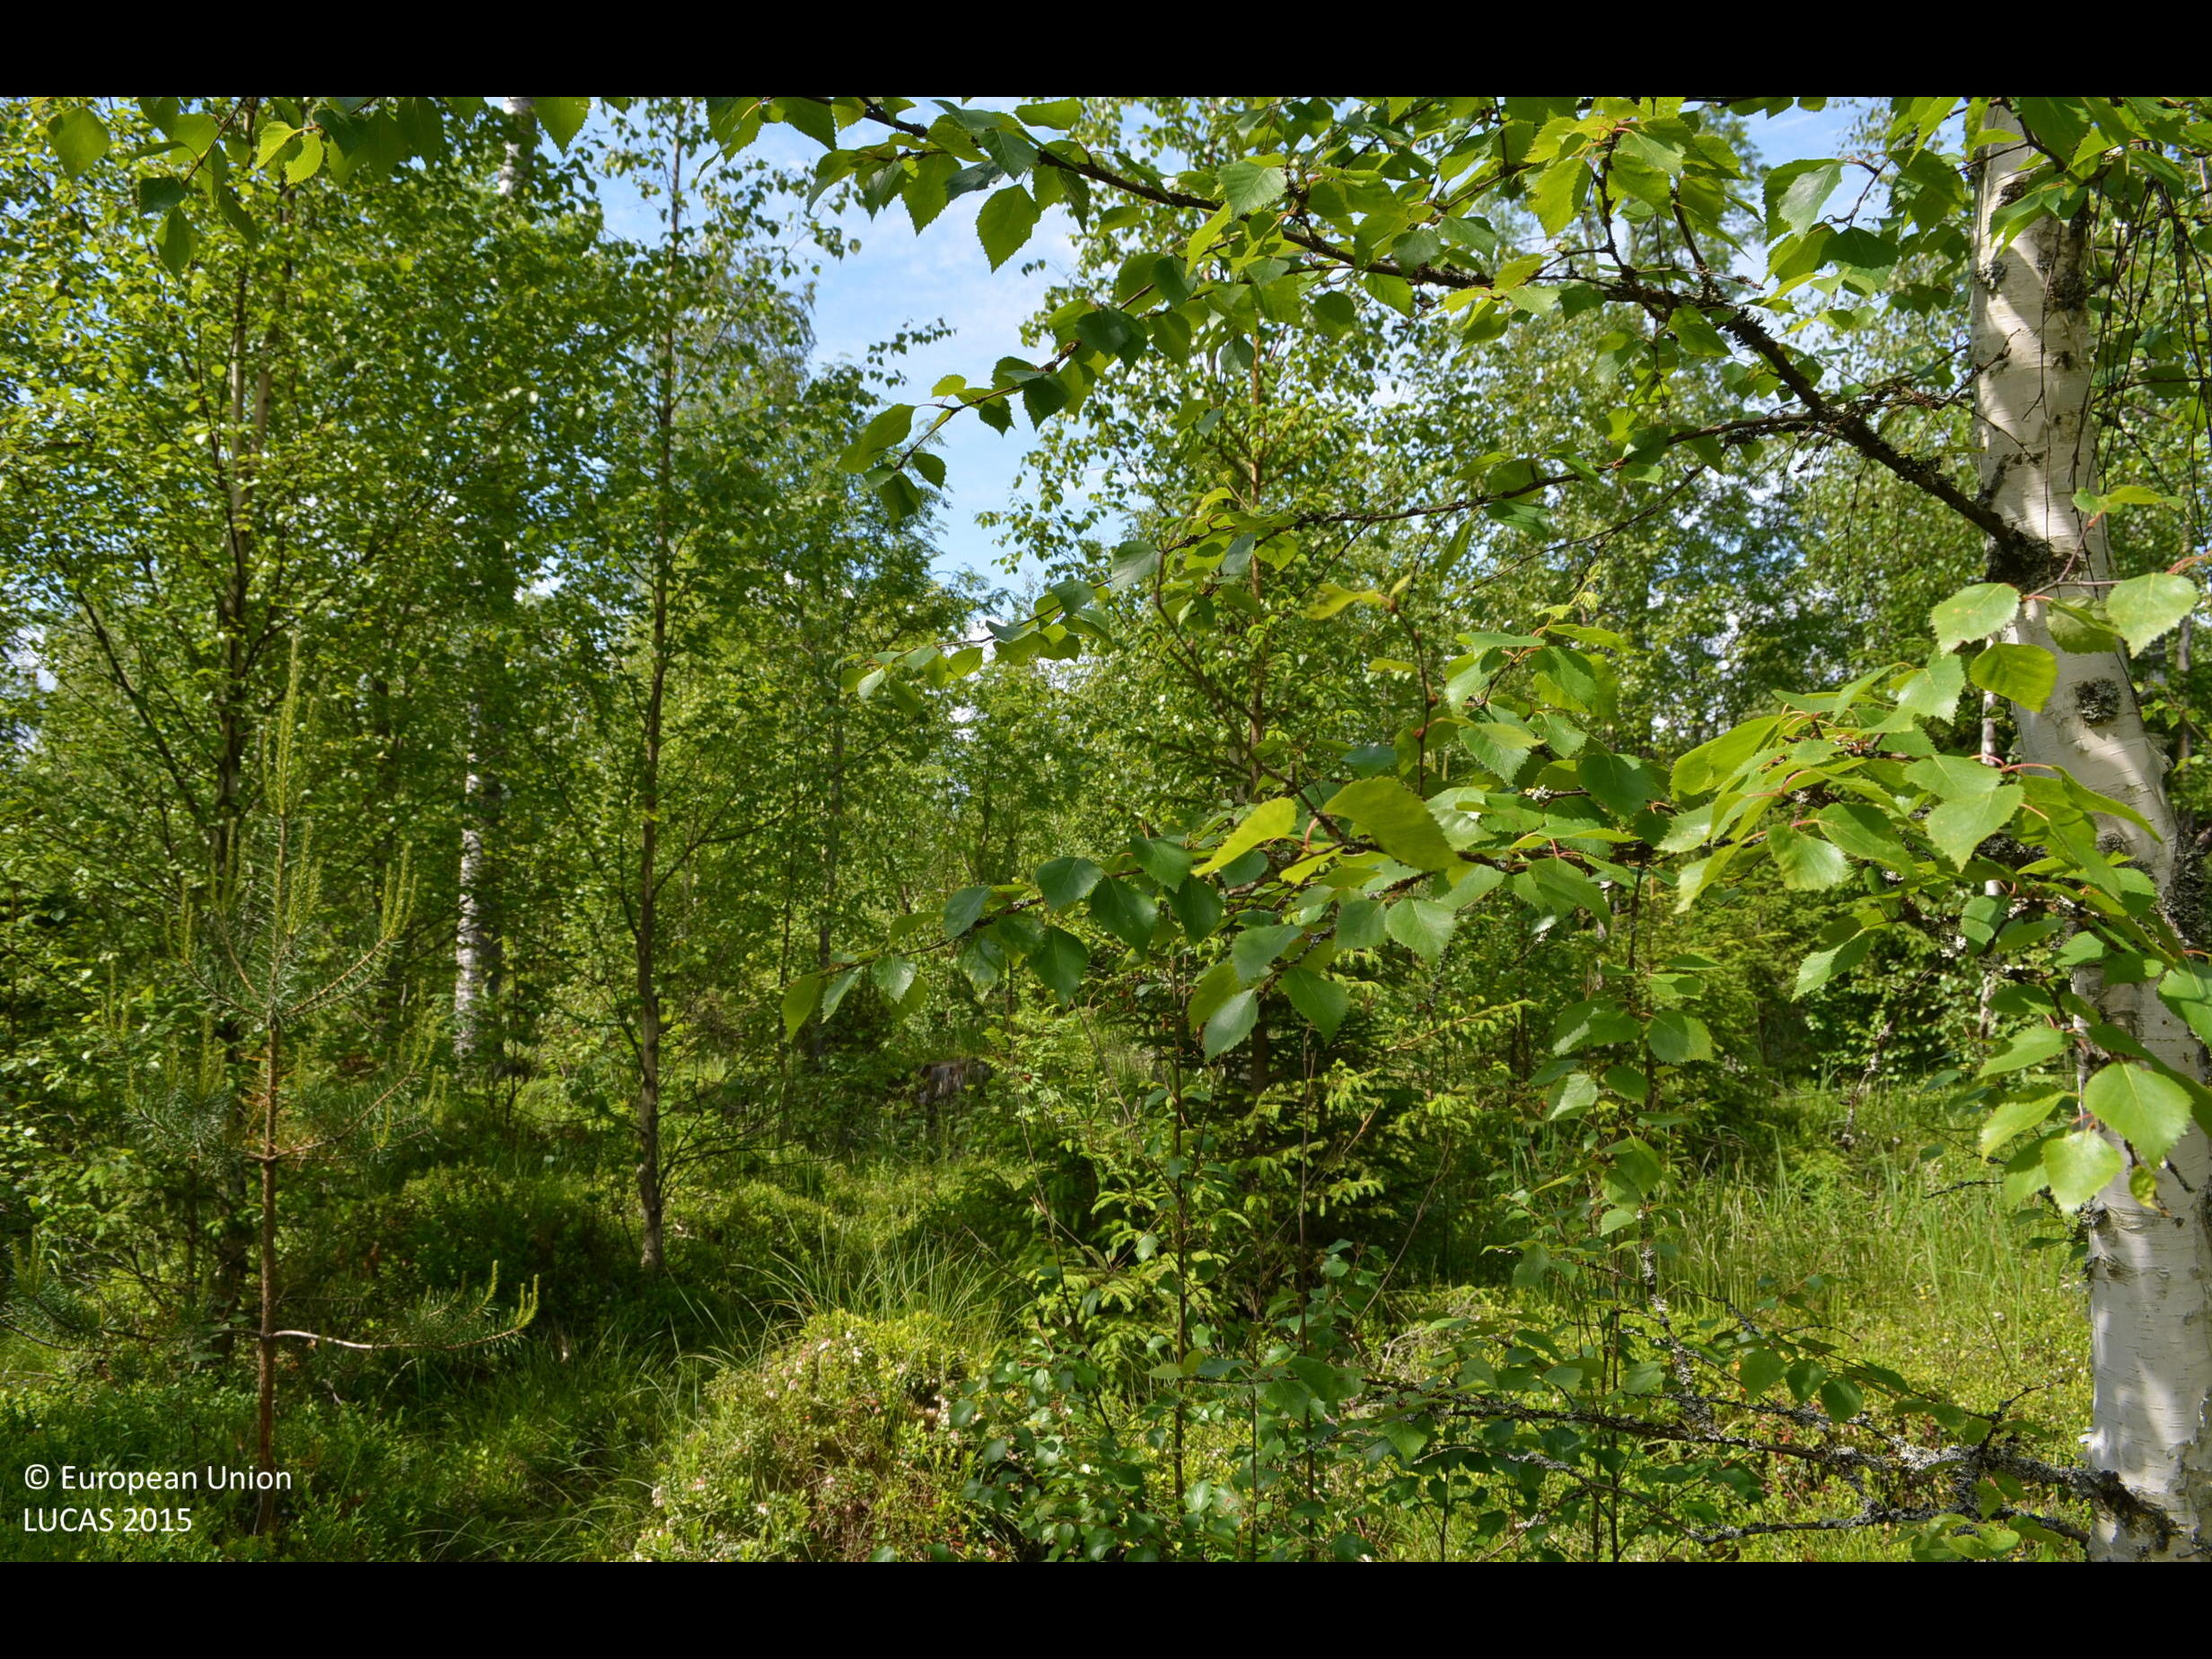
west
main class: Woodland
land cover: Other mixed woodland
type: boreal forest
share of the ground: > 75 %
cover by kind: broadleaved forest trees 40 %, coniferous forest trees 35 %, shrubs 20 %, herbaceous plants 5 %
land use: Forestry
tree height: < 5 m
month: June
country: FI
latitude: 61.6584
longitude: 23.2349
